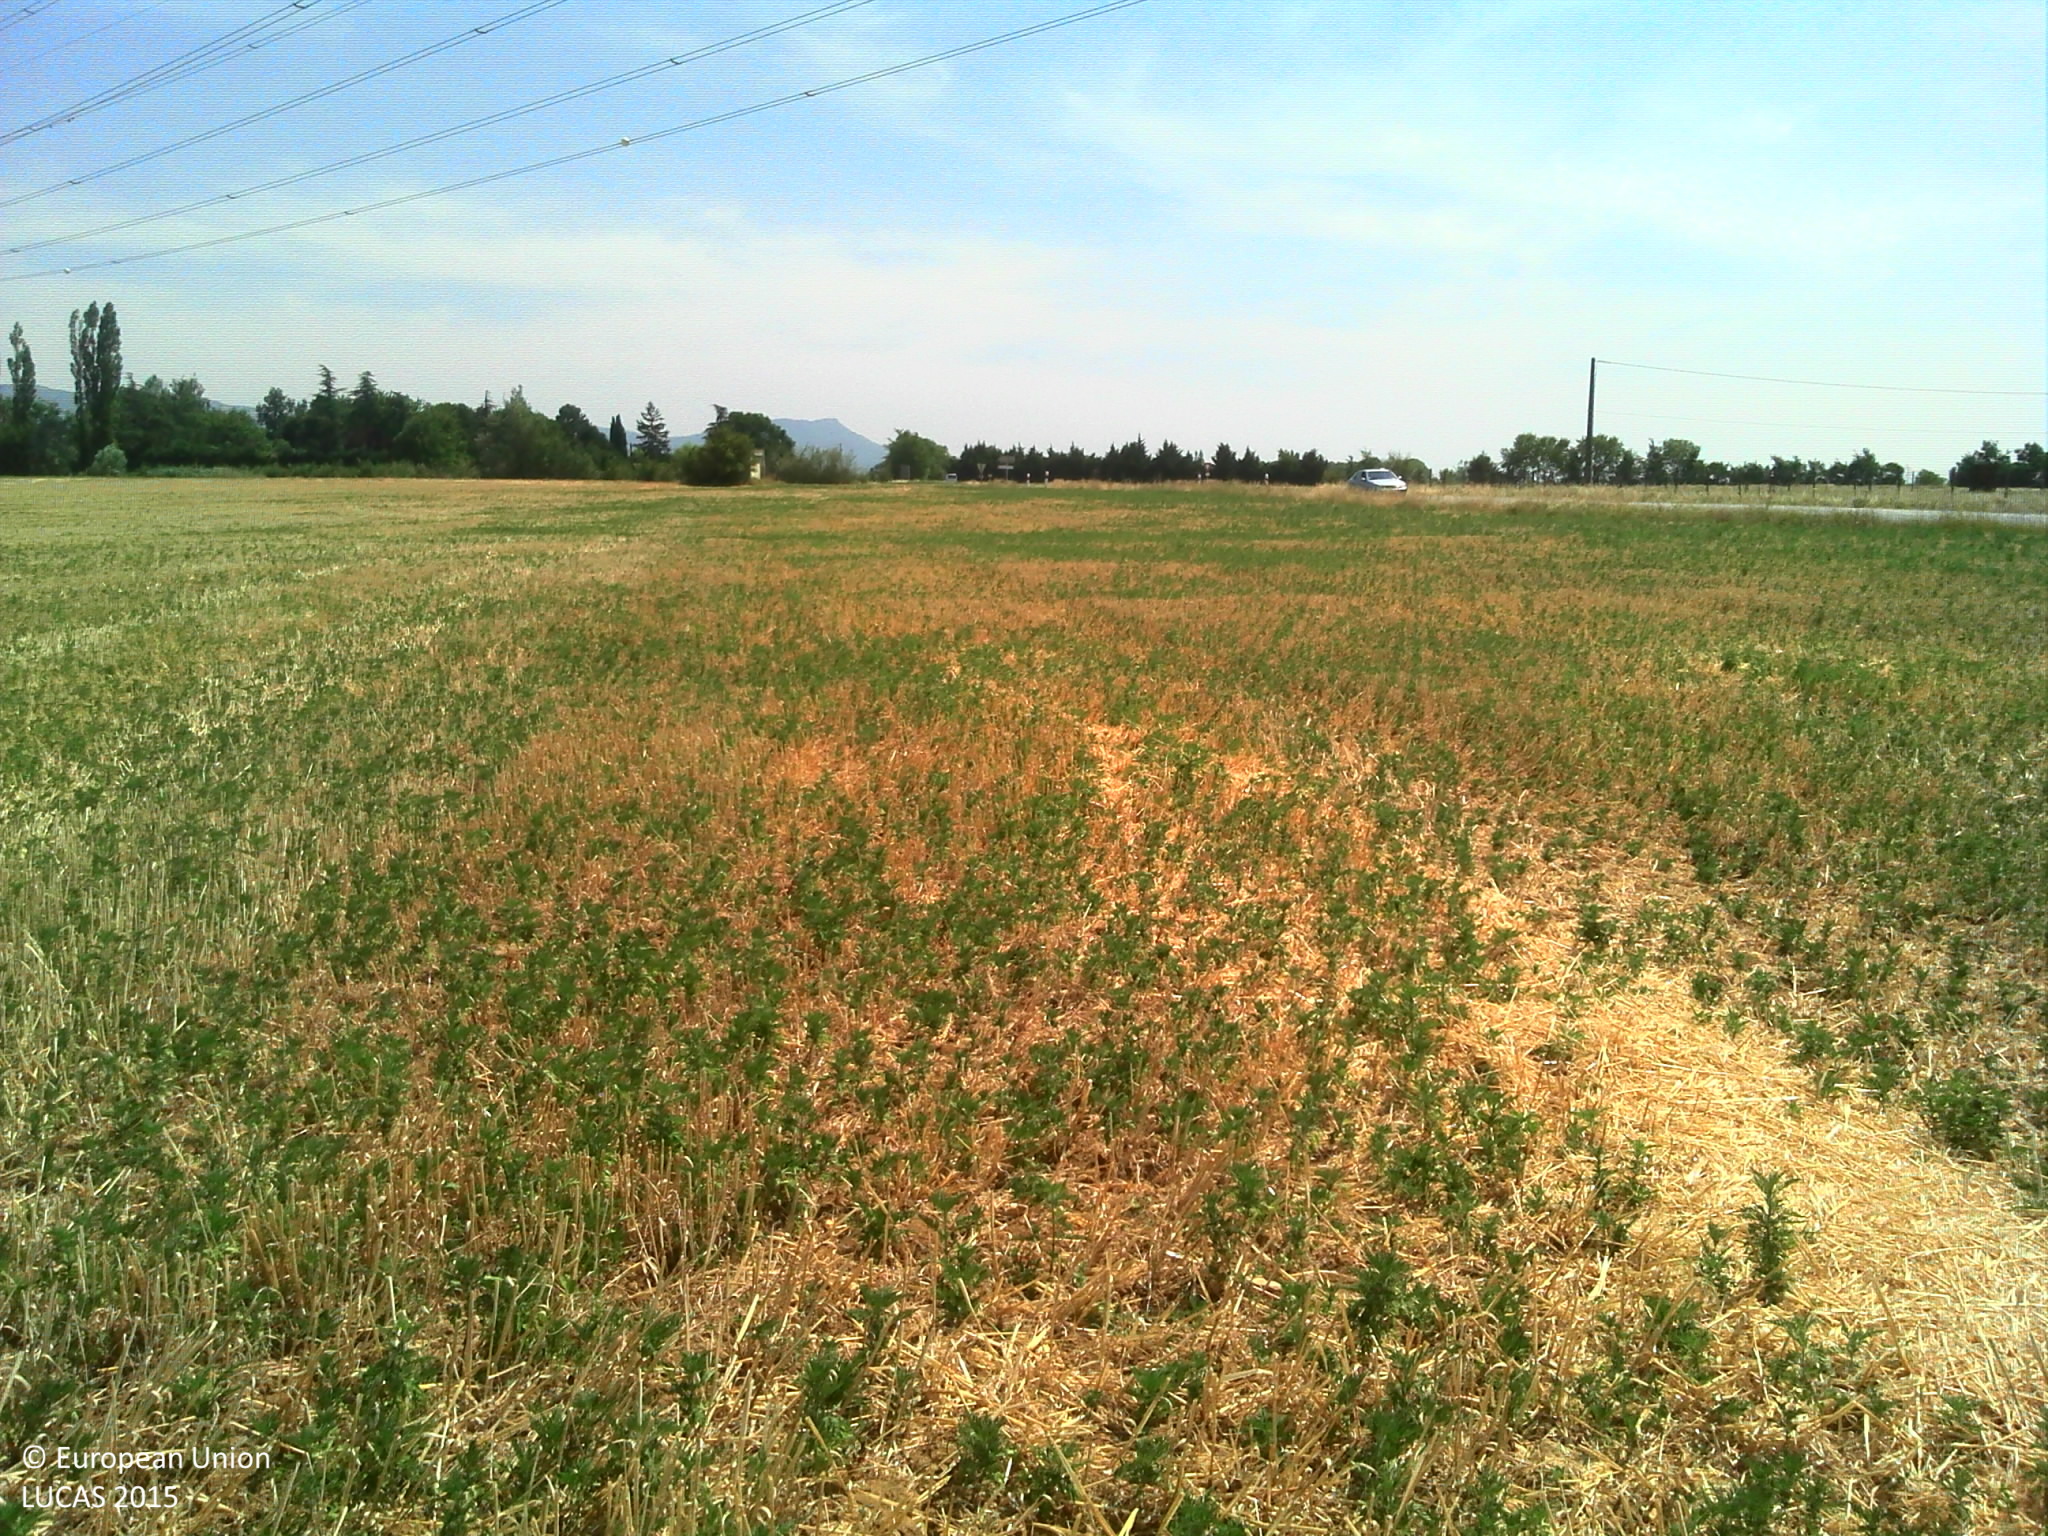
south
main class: Cropland
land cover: Barley
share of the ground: > 75 %
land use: Agriculture (excluding fallow land and kitchen gardens)
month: July
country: FR
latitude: 44.9538
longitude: 5.0242
